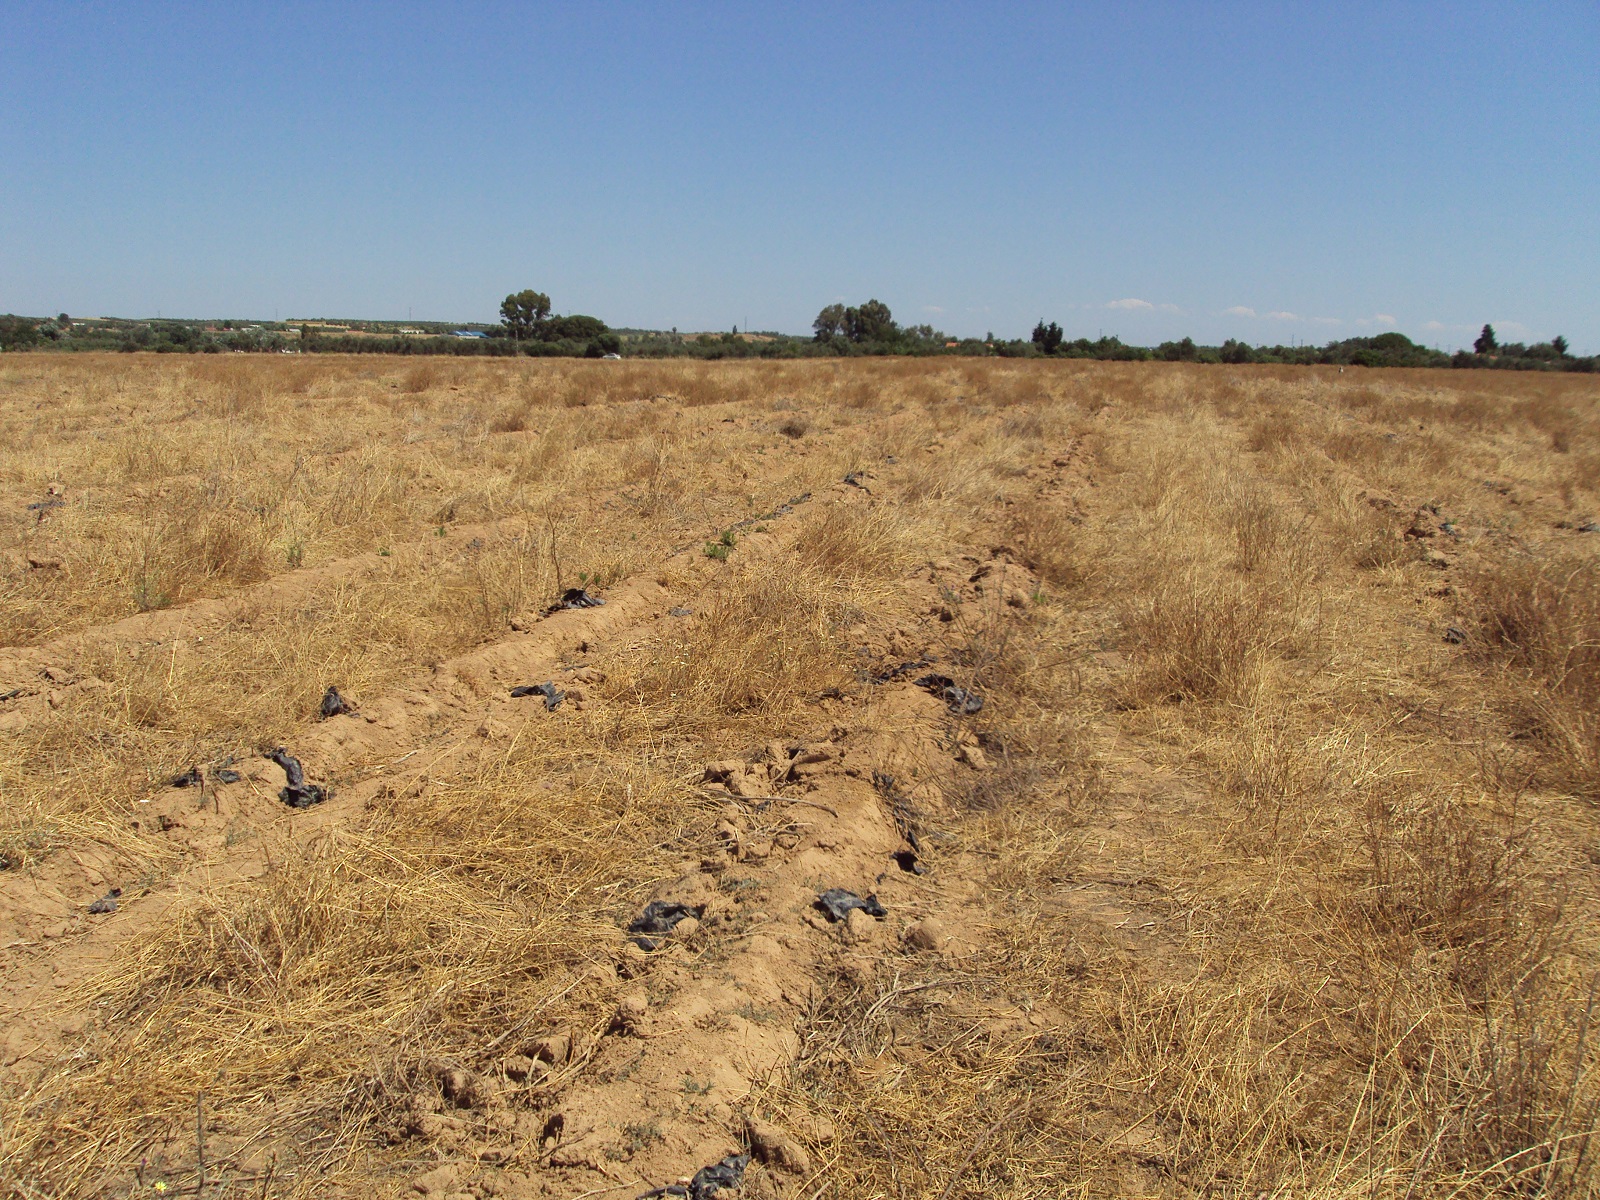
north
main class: Grassland
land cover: Grassland without tree/shrub cover
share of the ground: > 75 %
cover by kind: herbaceous plants 90 %, unconsolidated bare surface 10 %
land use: Agriculture (excluding fallow land and kitchen gardens)
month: June
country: ES
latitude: 37.3647
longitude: -6.9202
